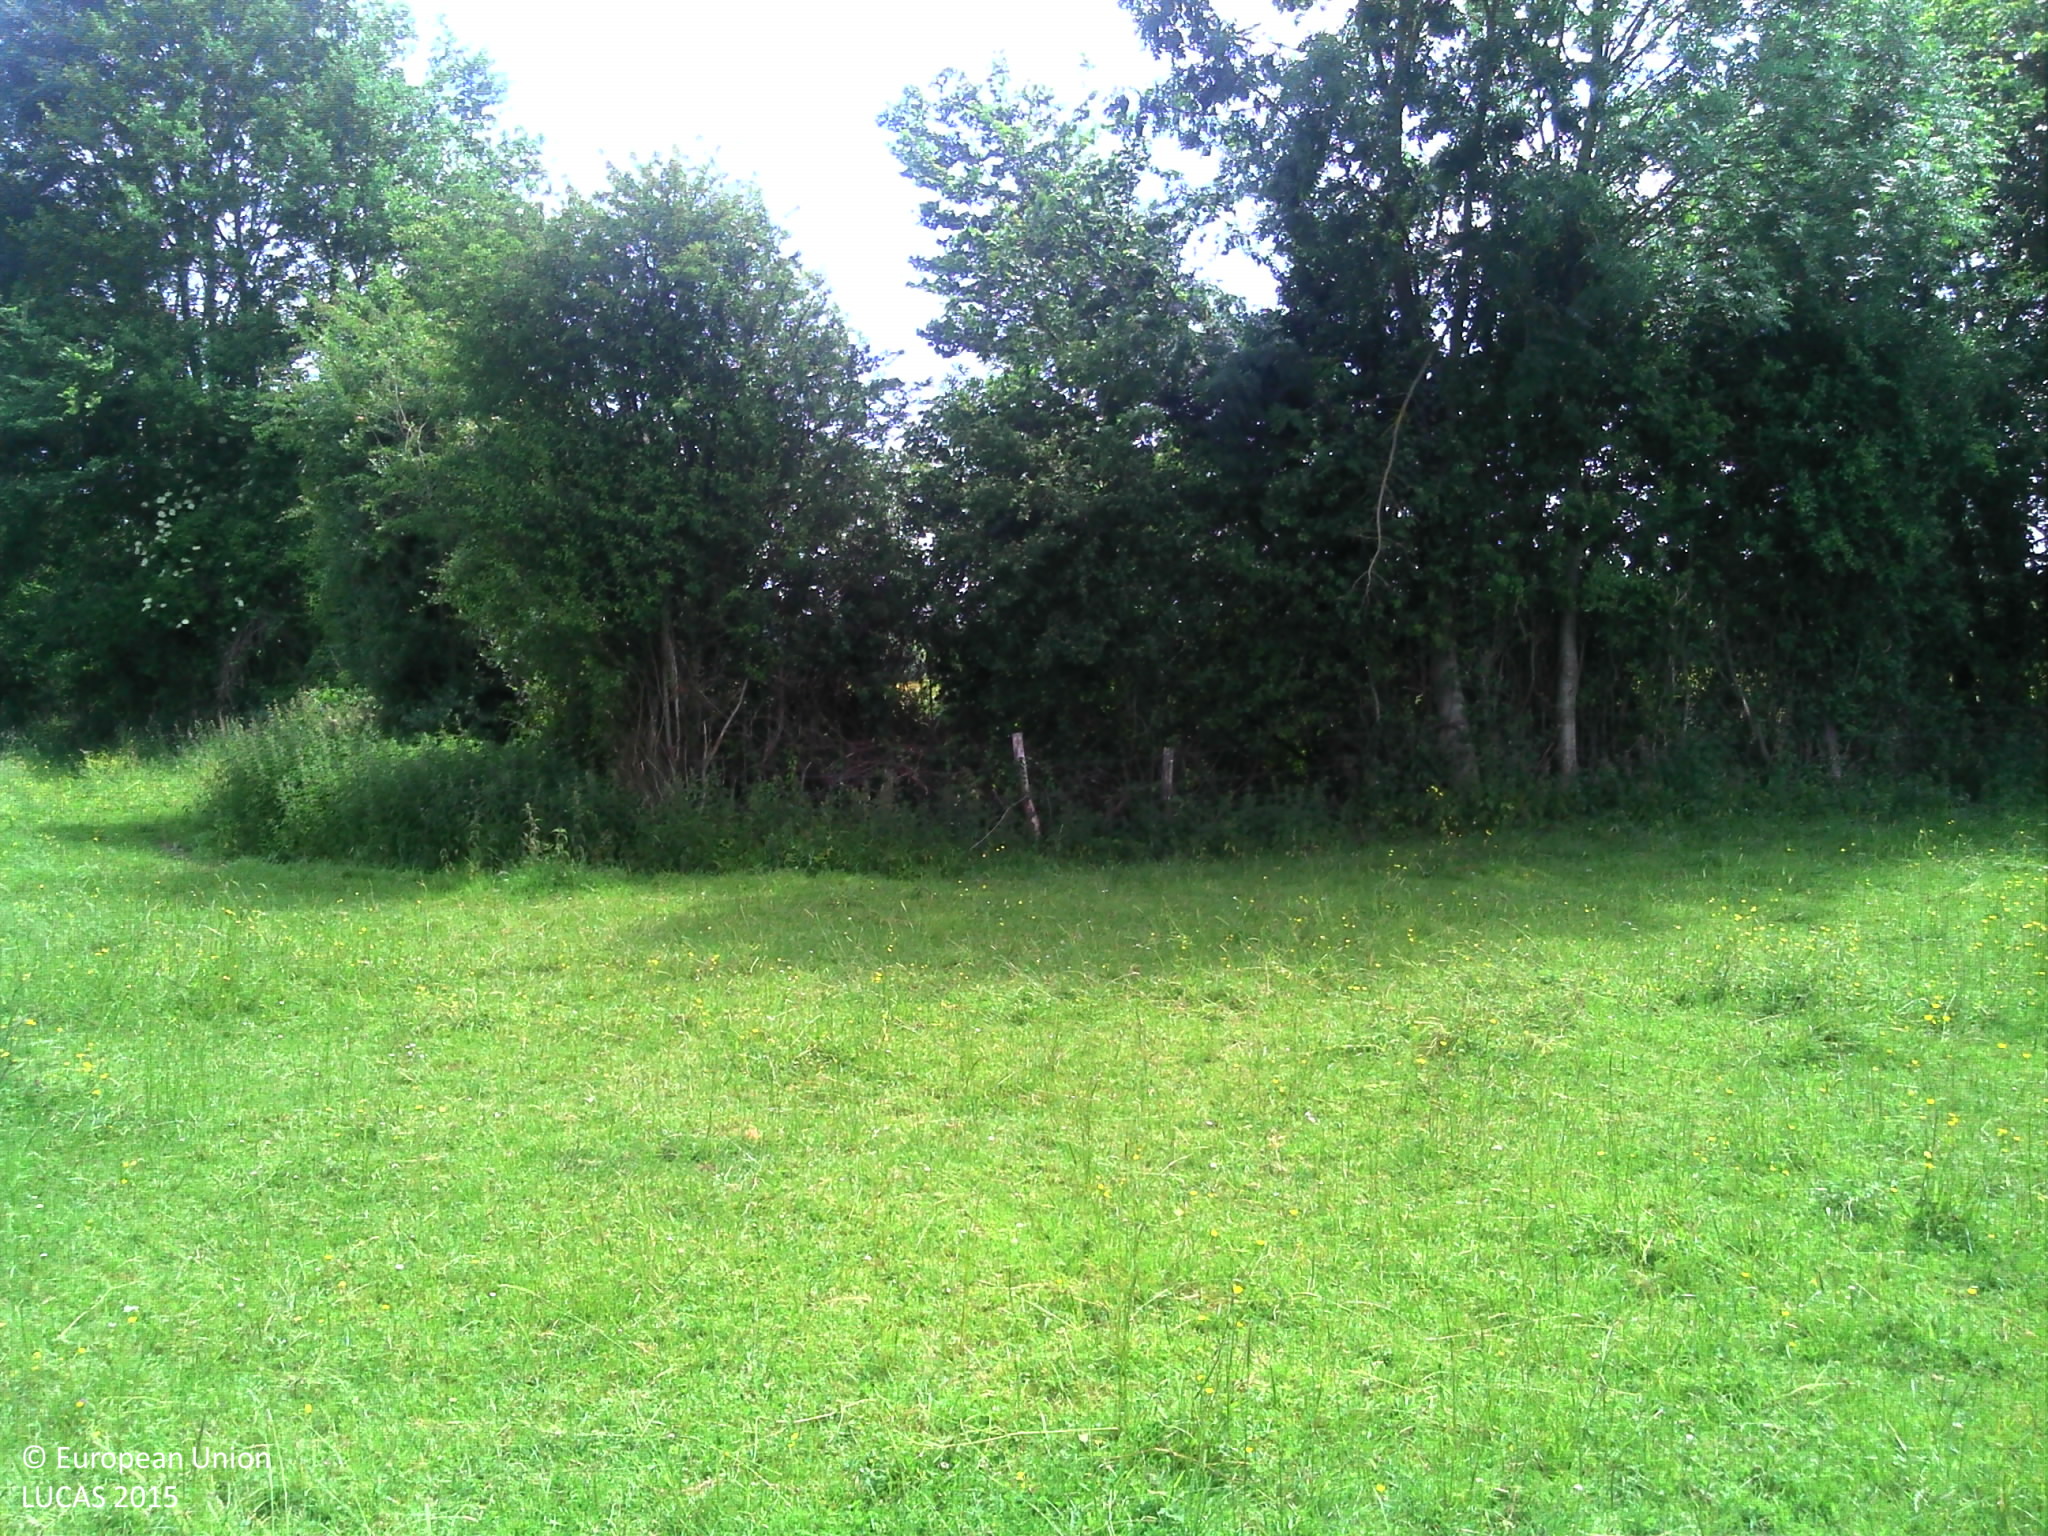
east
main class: Grassland
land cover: Grassland without tree/shrub cover
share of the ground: > 75 %
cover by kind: herbaceous plants 100 %
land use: Agriculture (excluding fallow land and kitchen gardens)
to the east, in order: Grassland without tree/shrub cover; Fences; Managed hedges; Rivers and streams; Managed hedges; Fences; Grassland without tree/shrub cover
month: June
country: FR
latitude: 48.5298
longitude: 0.2089
